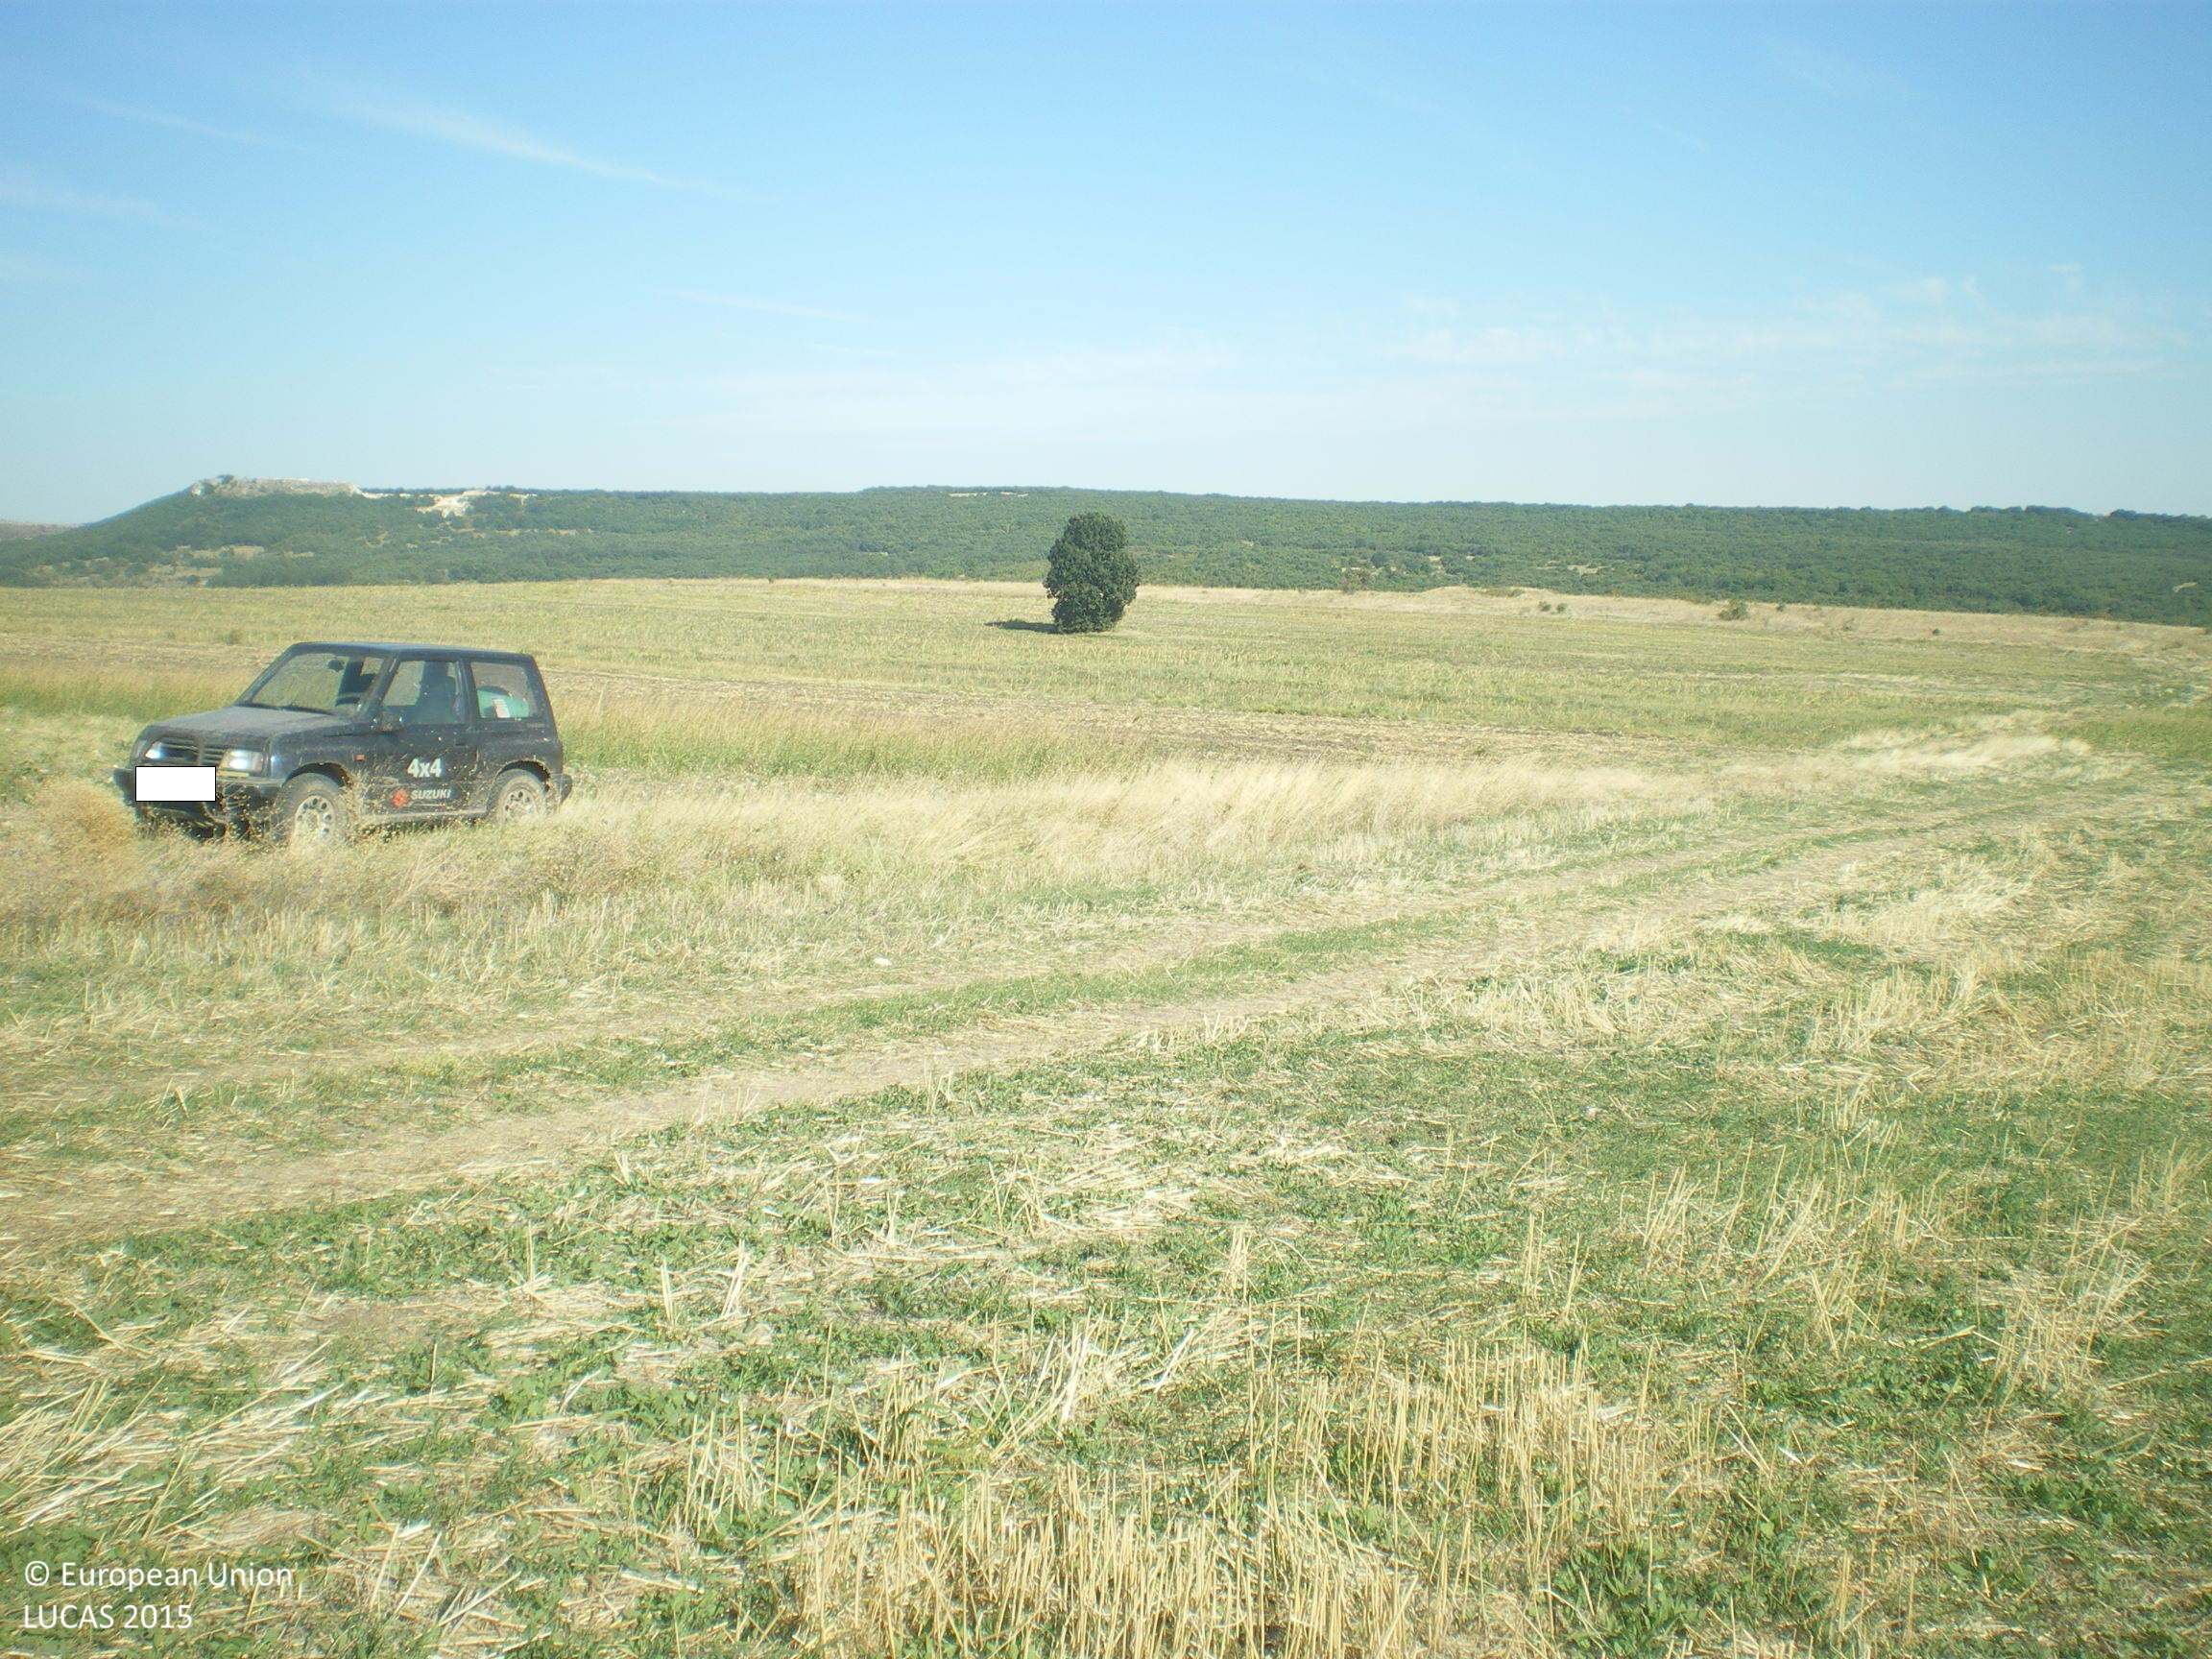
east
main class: Cropland
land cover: Common wheat
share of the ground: 10 - 25 %
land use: Agriculture (excluding fallow land and kitchen gardens)
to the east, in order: Common wheat; Tracks; Grass margins; Other cereals; Sunflower
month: September
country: BG
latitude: 41.8342
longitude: 26.3235
